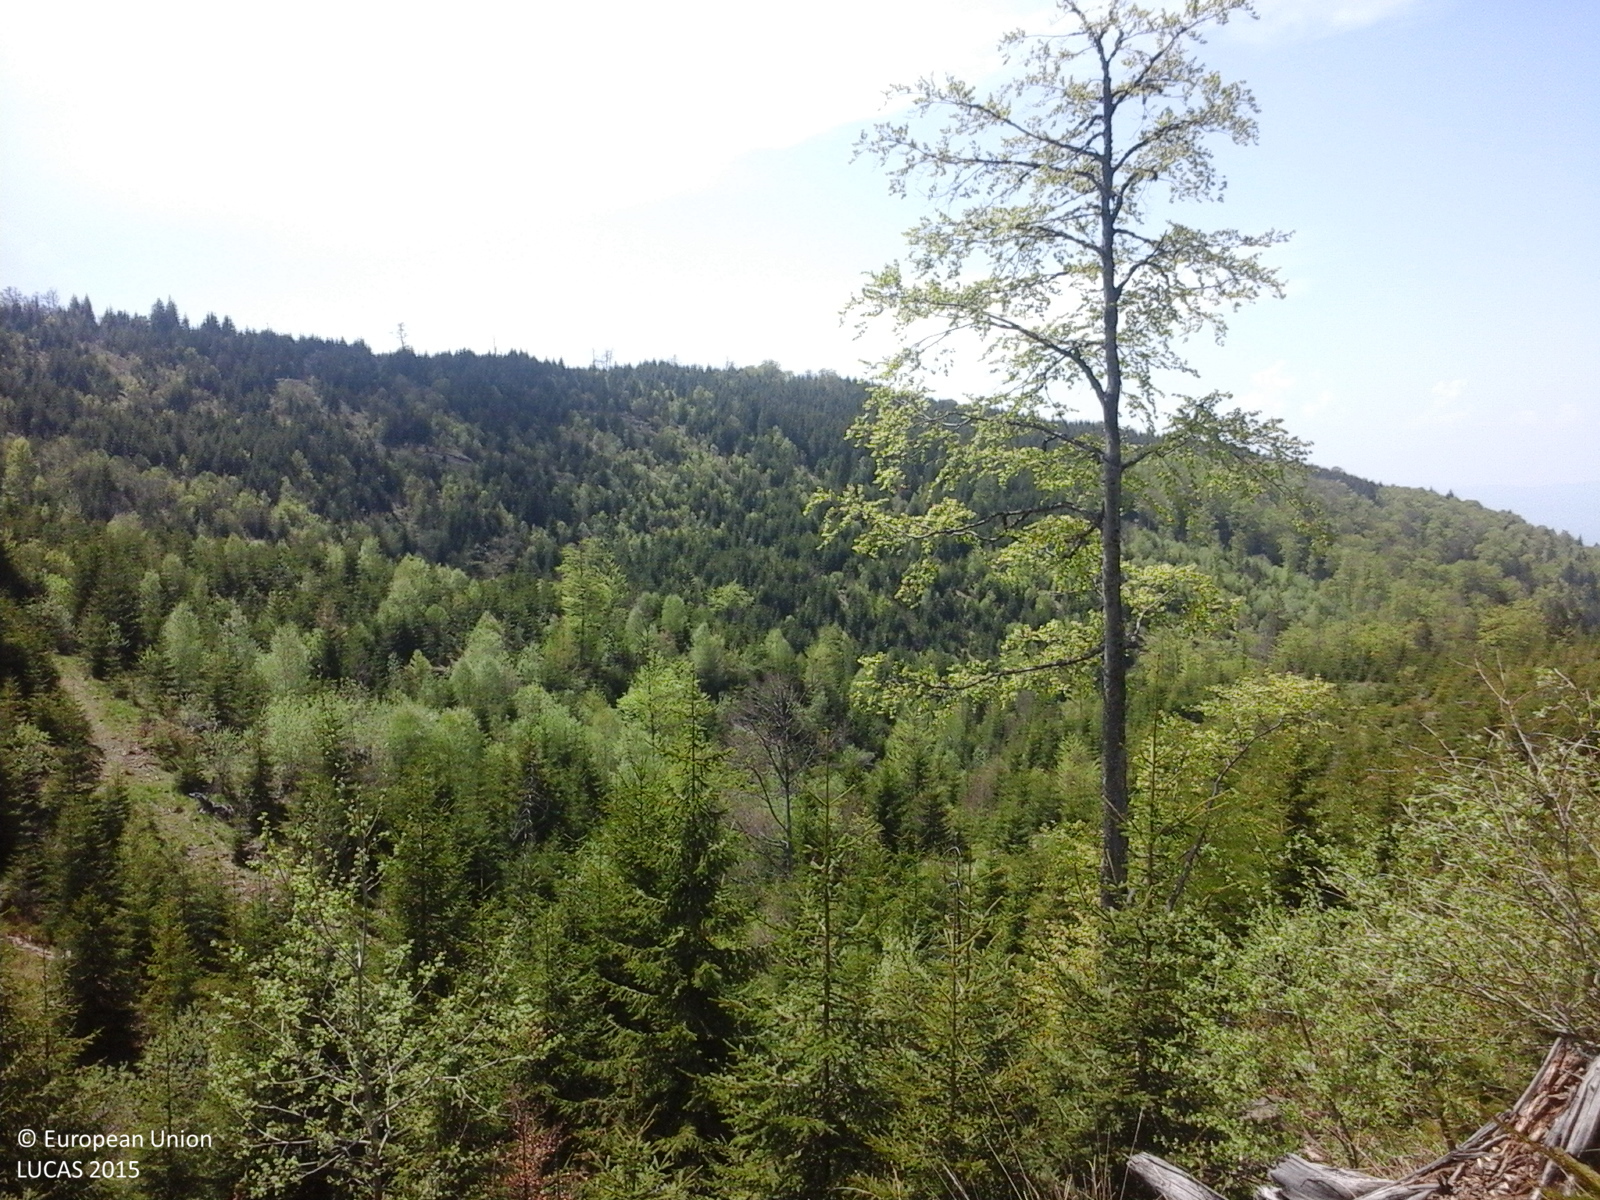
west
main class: Woodland
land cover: Spruce dominated mixed woodland
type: alpine coniferous forest
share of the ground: > 75 %
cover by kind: coniferous forest trees 75 %, broadleaved forest trees 25 %
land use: Forestry
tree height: > 5 m
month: May
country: RO
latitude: 45.8631
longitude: 26.2885
